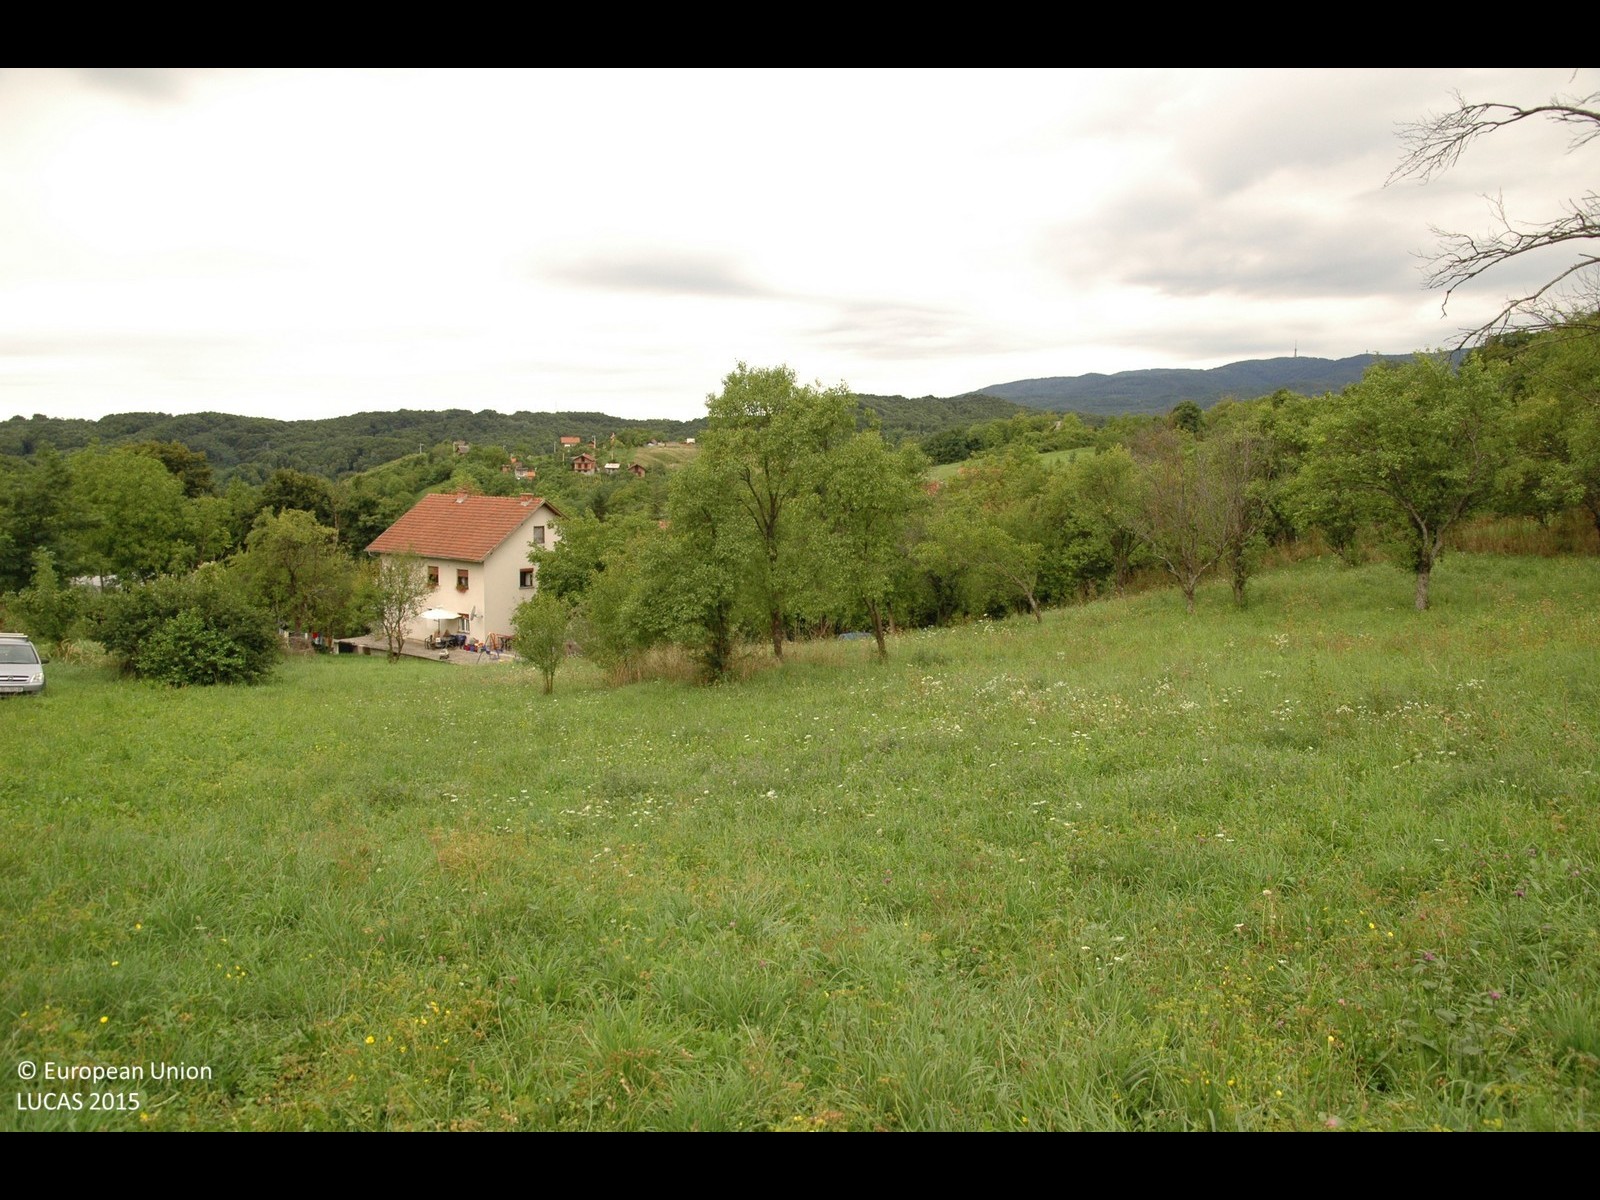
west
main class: Grassland
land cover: Grassland without tree/shrub cover
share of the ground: > 75 %
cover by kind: herbaceous plants 100 %
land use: Agriculture (excluding fallow land and kitchen gardens)
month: August
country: HR
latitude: 45.8720
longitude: 16.0660
